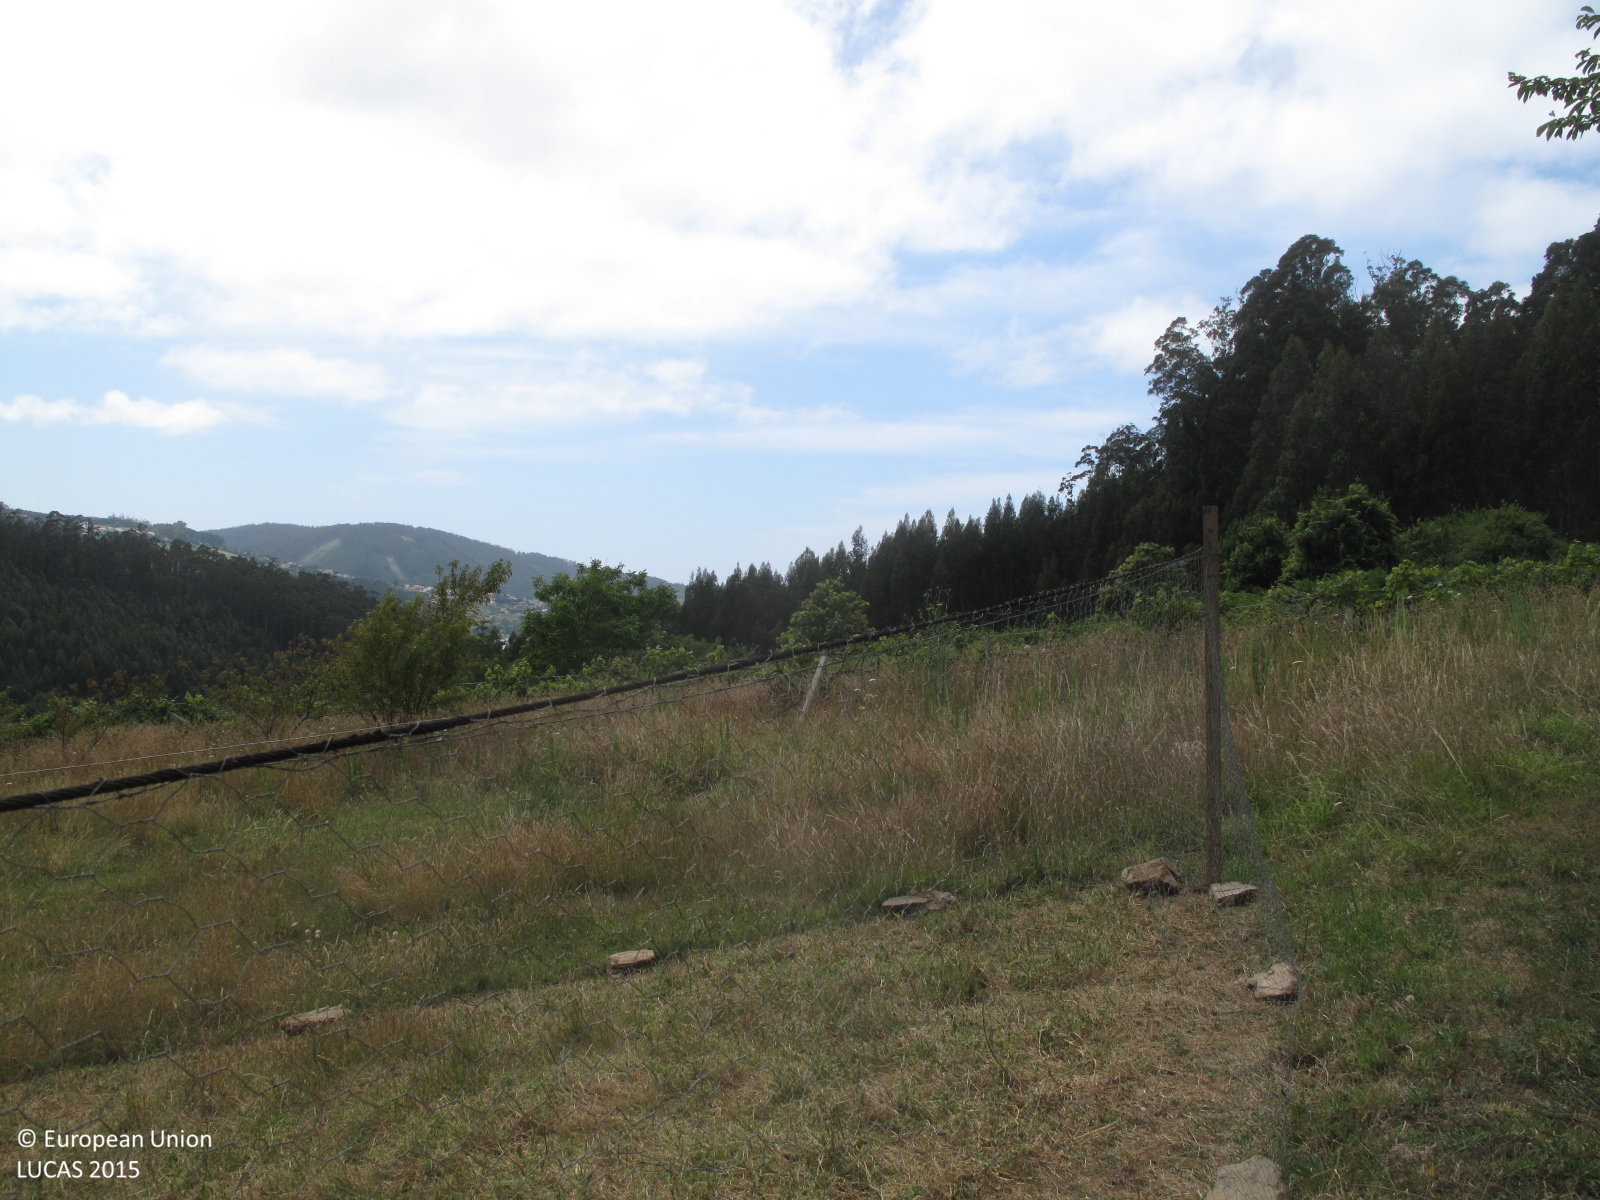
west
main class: Grassland
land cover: Grassland with sparse tree/shrub cover
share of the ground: > 75 %
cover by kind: herbaceous plants 95 %, broadleaved forest trees 5 %
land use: Residential
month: July
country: ES
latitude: 43.6395
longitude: -8.0360
